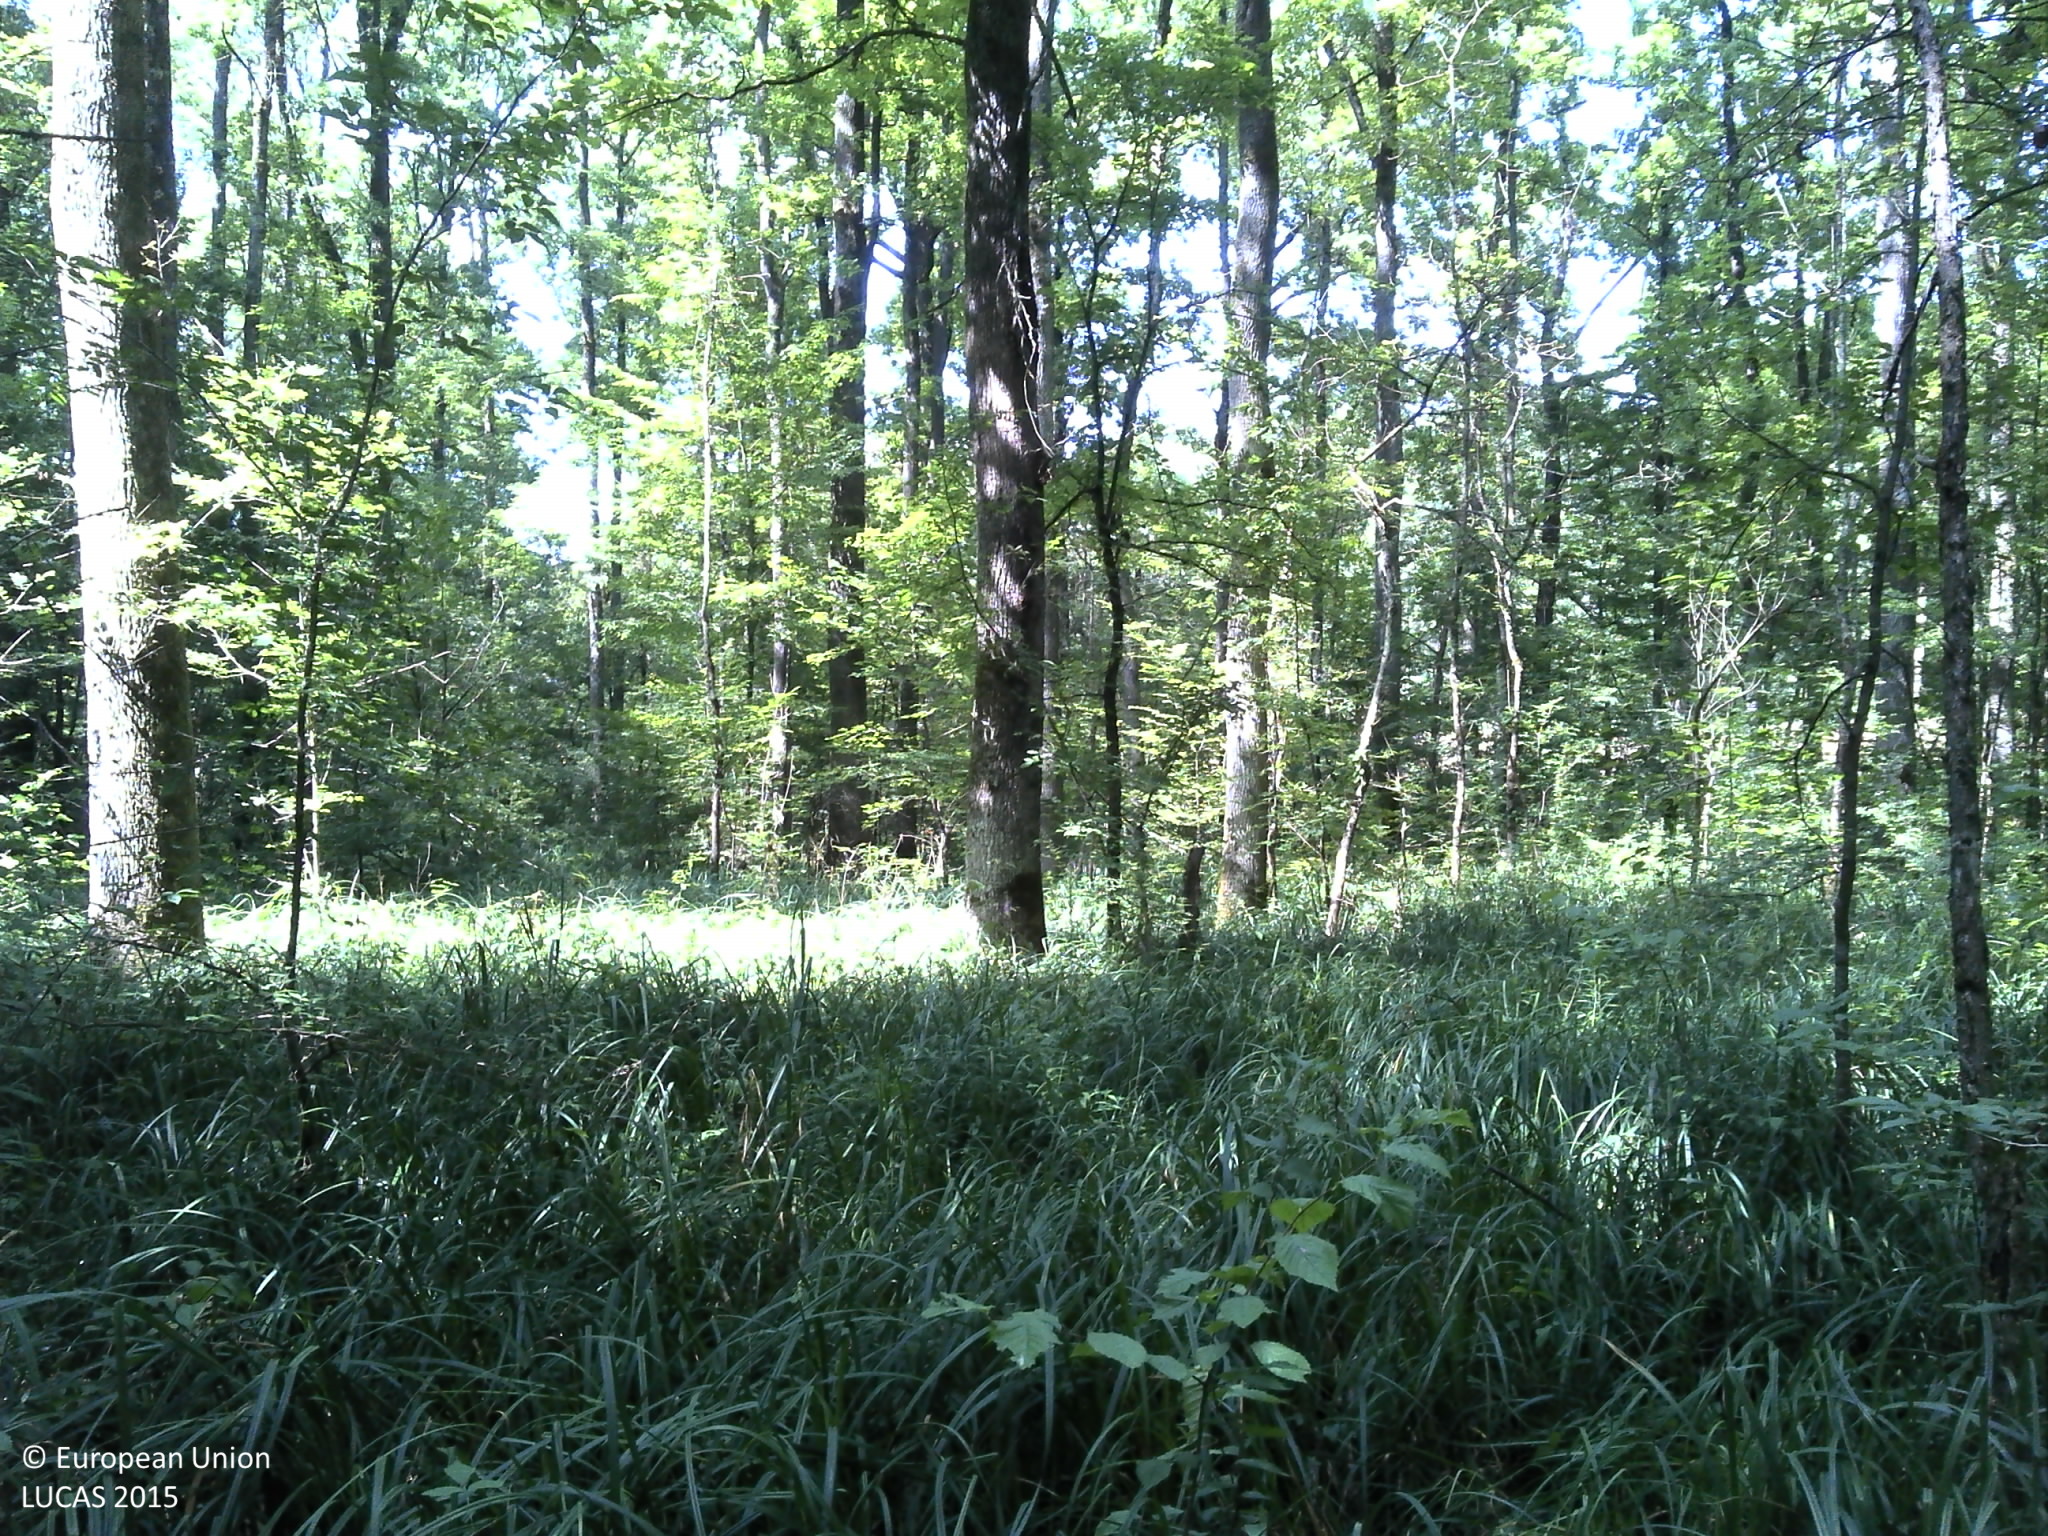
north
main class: Woodland
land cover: Broadleaved woodland
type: acidophilous oak and oak-birch forest
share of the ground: > 75 %
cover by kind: broadleaved forest trees 80 %, lichens and mosses 20 %
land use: Forestry
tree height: > 5 m
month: August
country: HR
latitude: 45.5021
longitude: 16.5125
